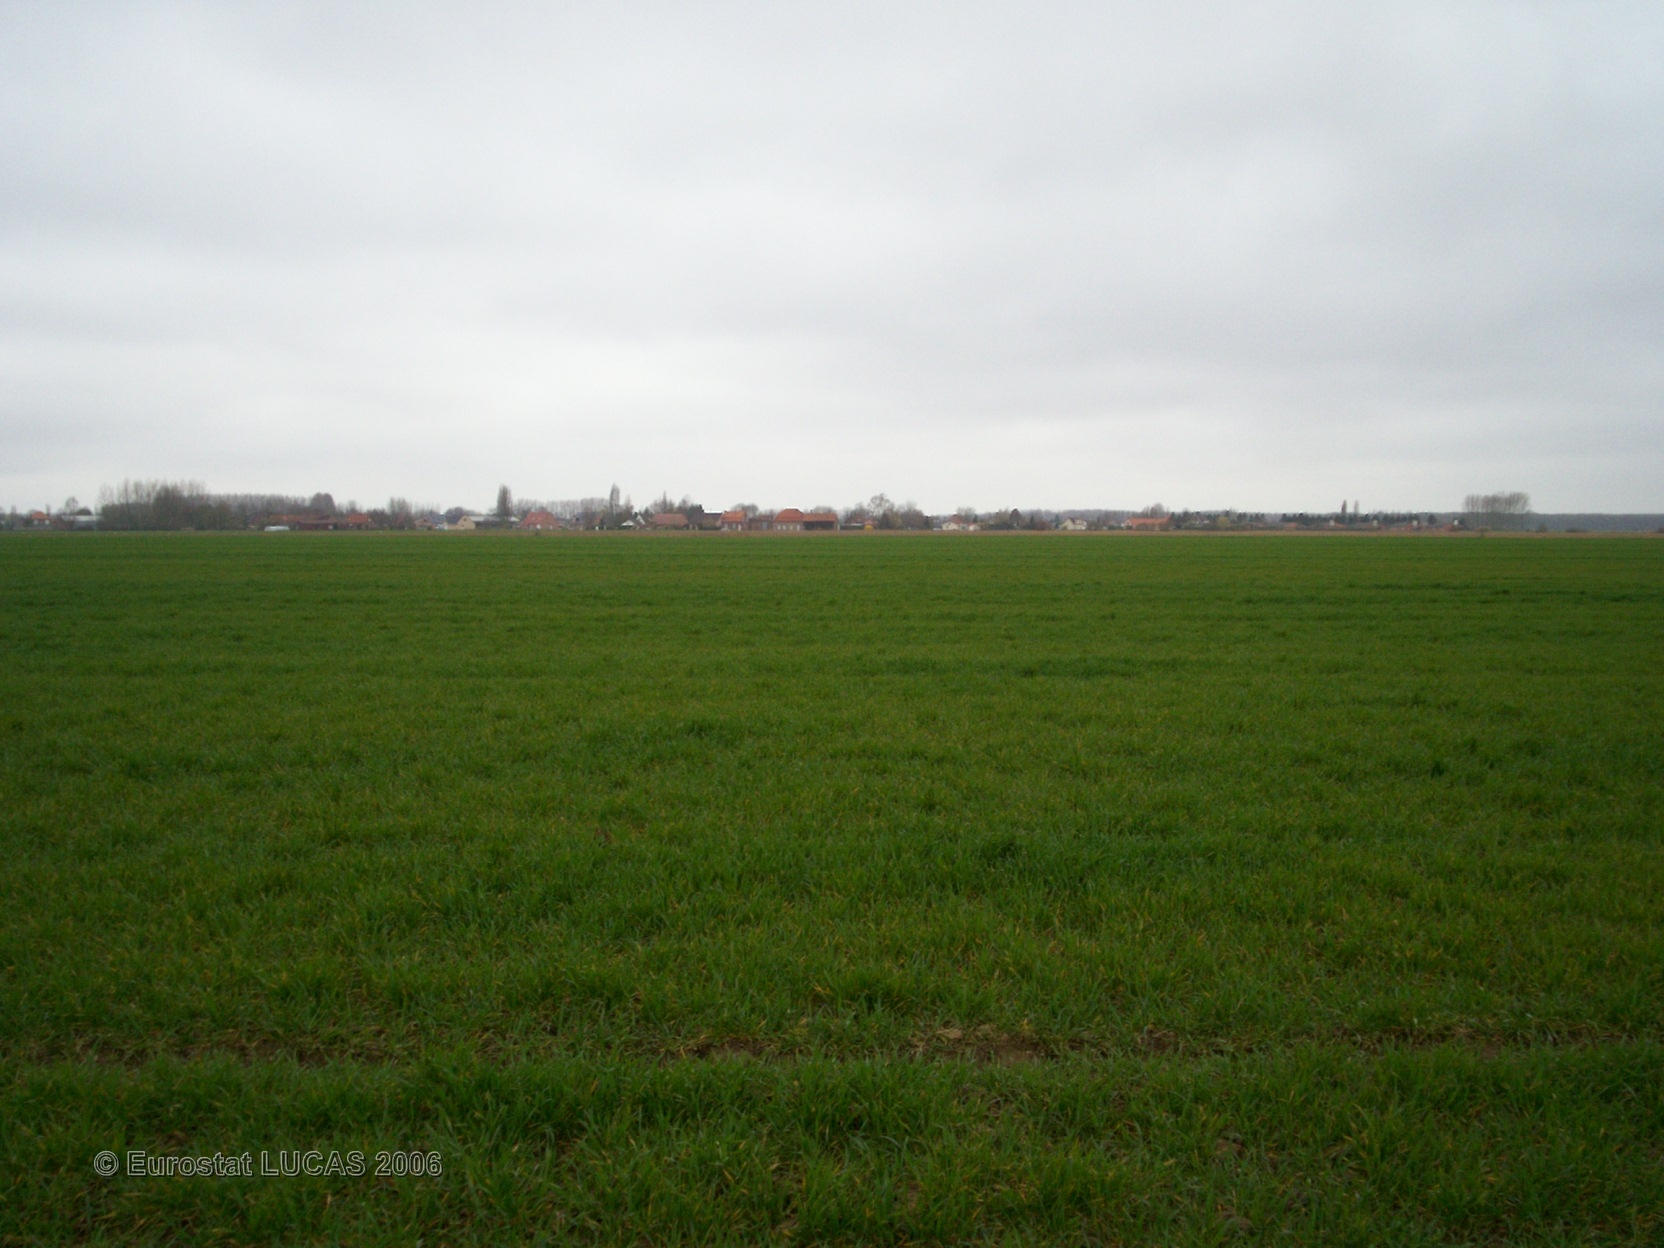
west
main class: Cropland
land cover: Common wheat
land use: Agriculture (excluding fallow land and kitchen gardens)
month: April
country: FR
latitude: 50.6455
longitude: 2.5631
